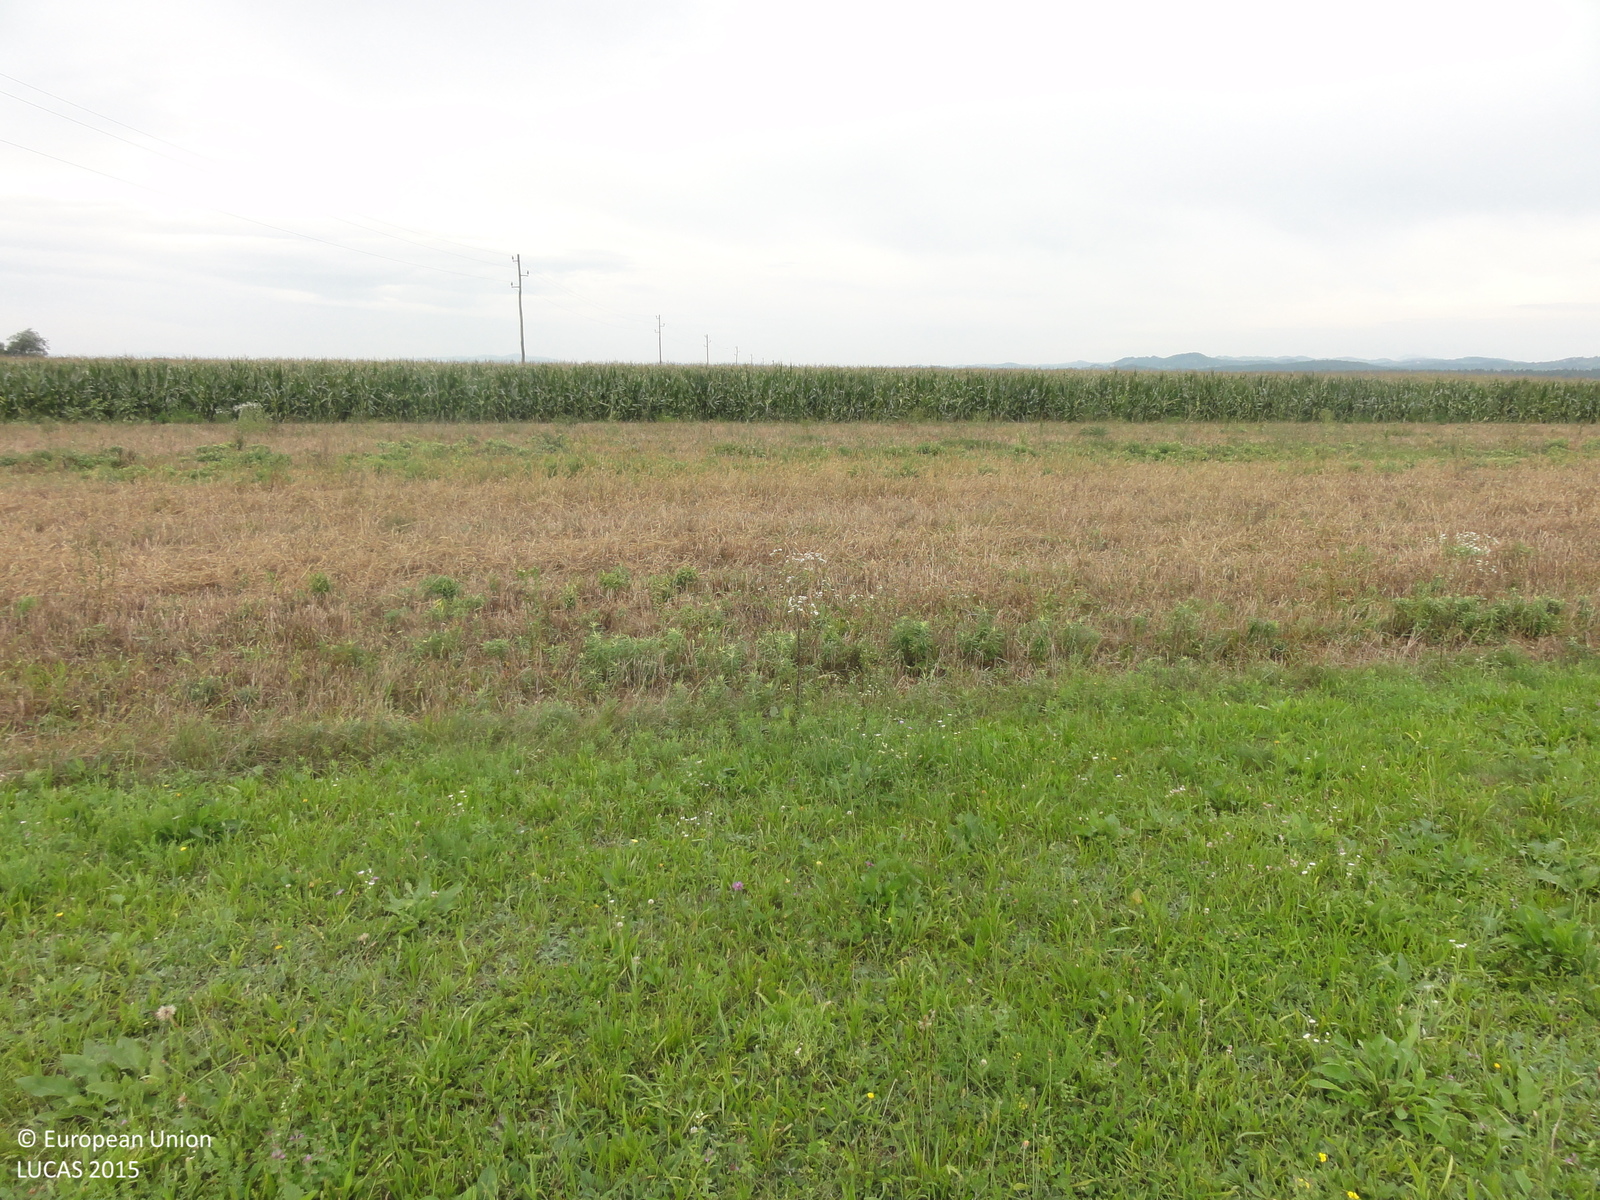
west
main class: Grassland
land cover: Grassland without tree/shrub cover
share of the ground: > 75 %
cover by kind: herbaceous plants 100 %
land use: Agriculture (excluding fallow land and kitchen gardens)
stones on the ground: < 10 %
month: August
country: SI
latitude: 45.9041
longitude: 15.4755
